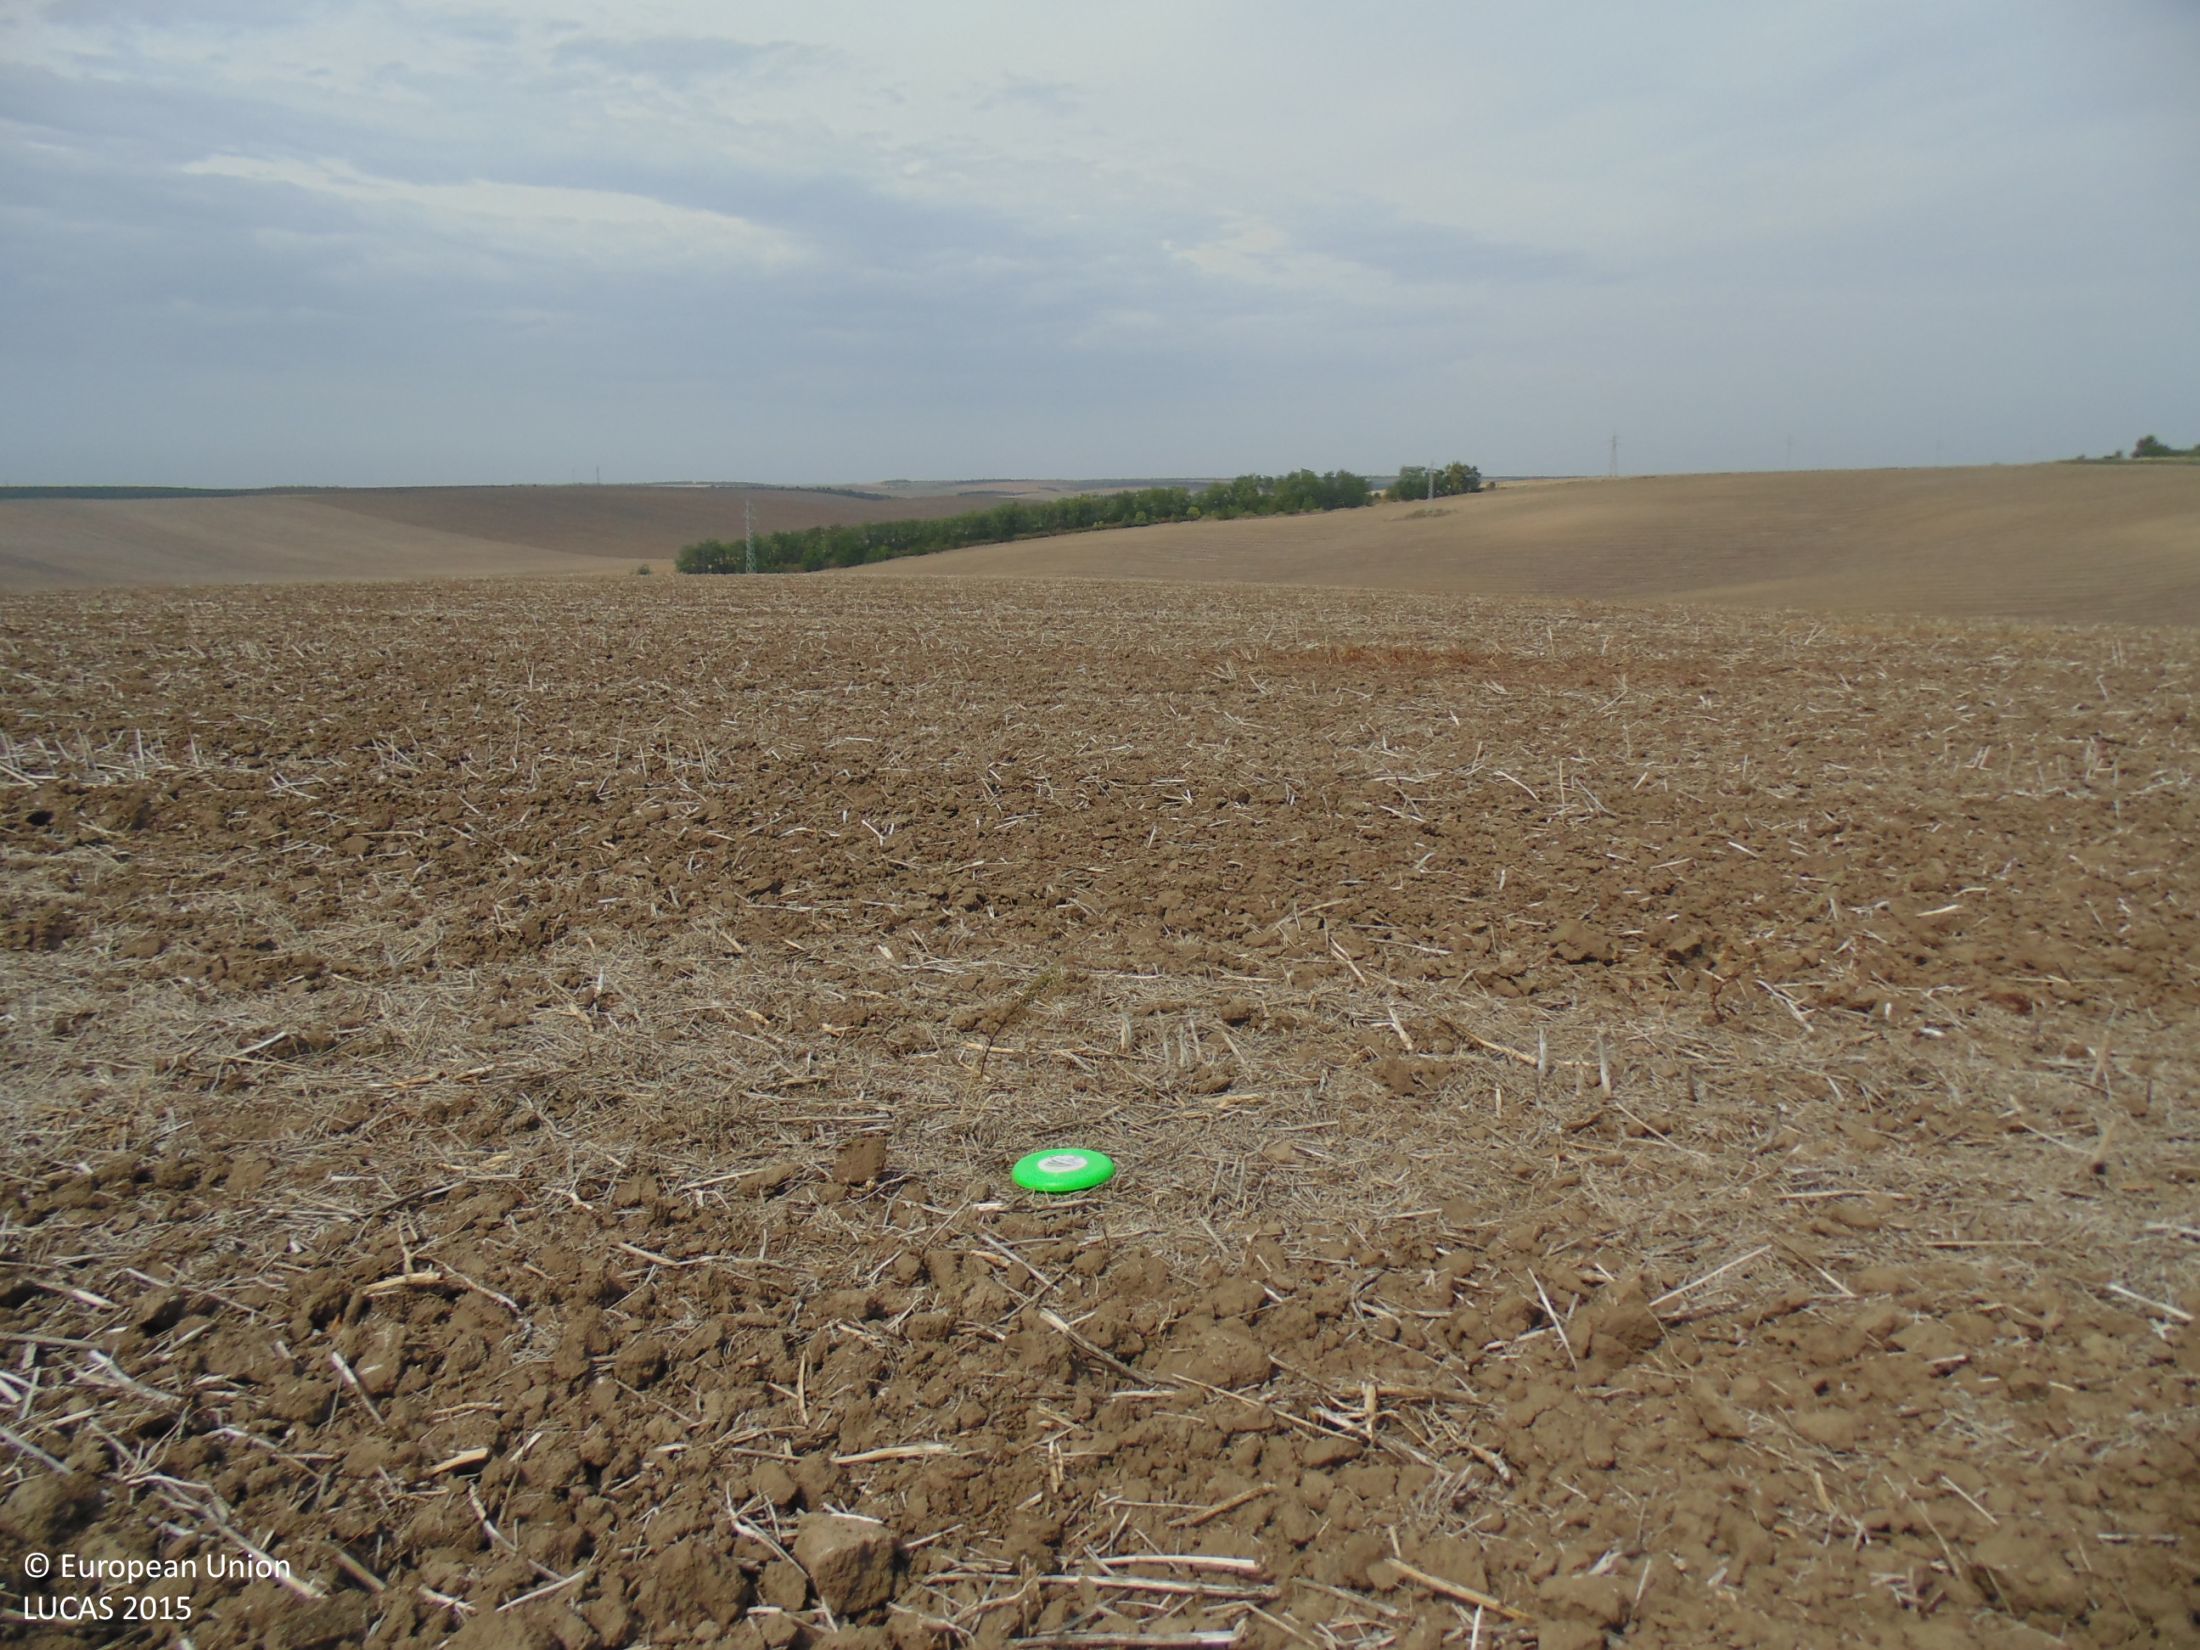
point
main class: Cropland
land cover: Rape and turnip rape
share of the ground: < 10 %
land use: Agriculture (excluding fallow land and kitchen gardens)
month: September
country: BG
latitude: 43.9877
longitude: 27.1976
